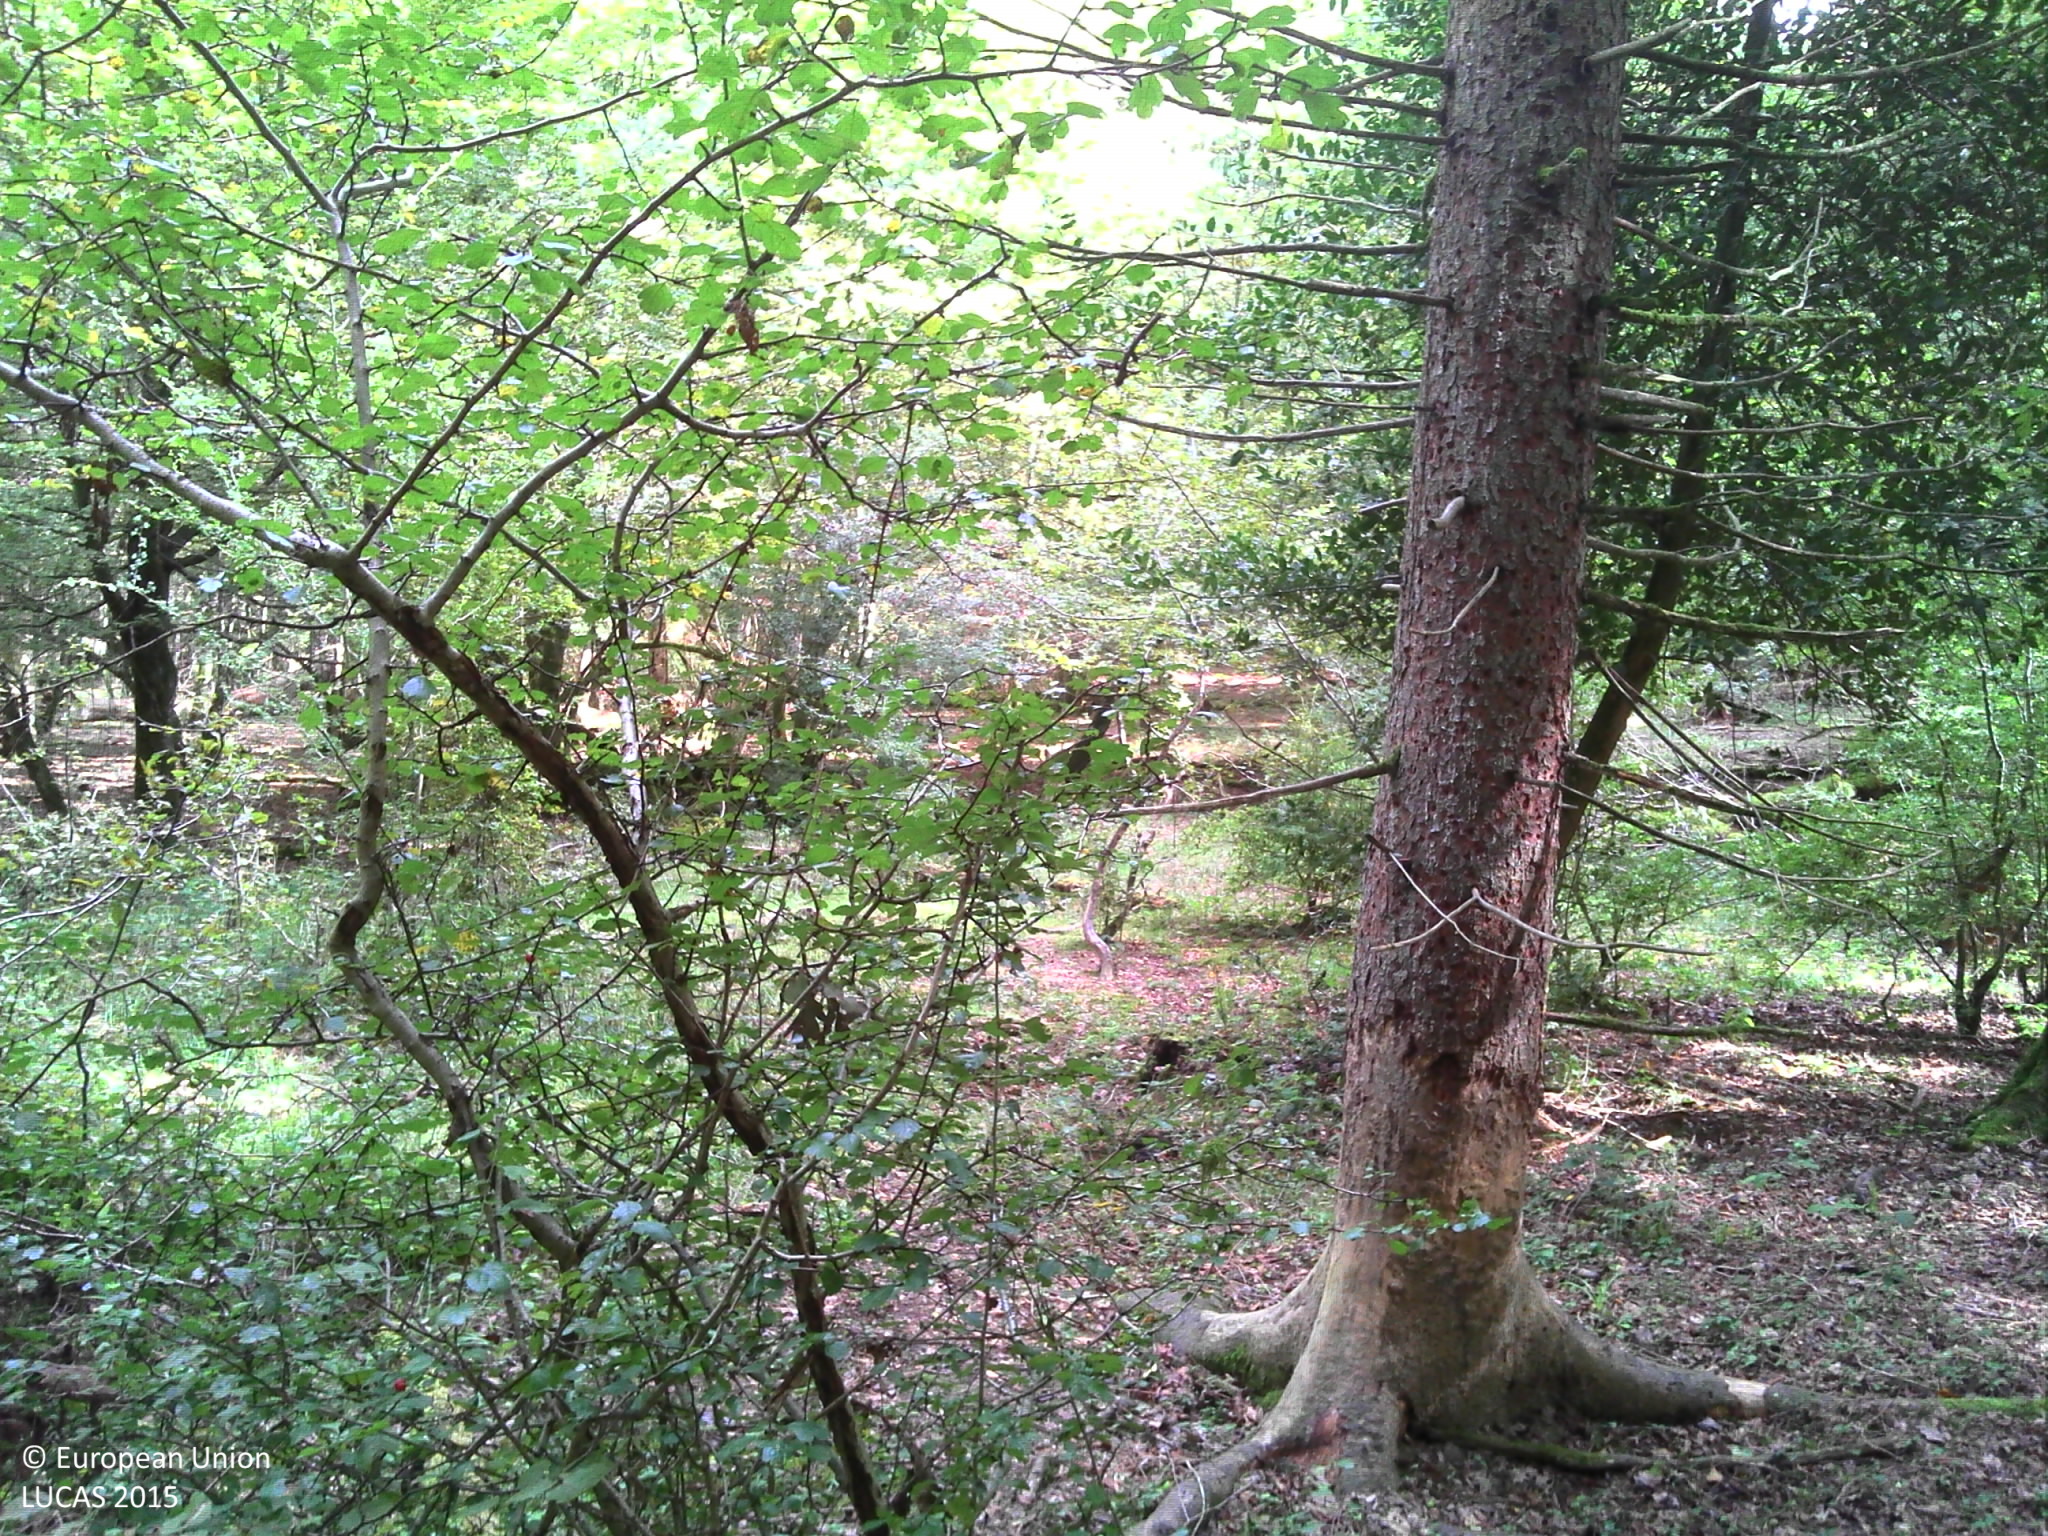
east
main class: Woodland
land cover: Broadleaved woodland
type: mesophytic deciduous forest
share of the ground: > 75 %
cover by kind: broadleaved forest trees 90 %, herbaceous plants 5 %, lichens and mosses 5 %
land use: Forestry
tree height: > 5 m
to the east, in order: Broadleaved woodland; Tracks; Broadleaved woodland
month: September
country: FR
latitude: 48.0012
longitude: 4.2476
